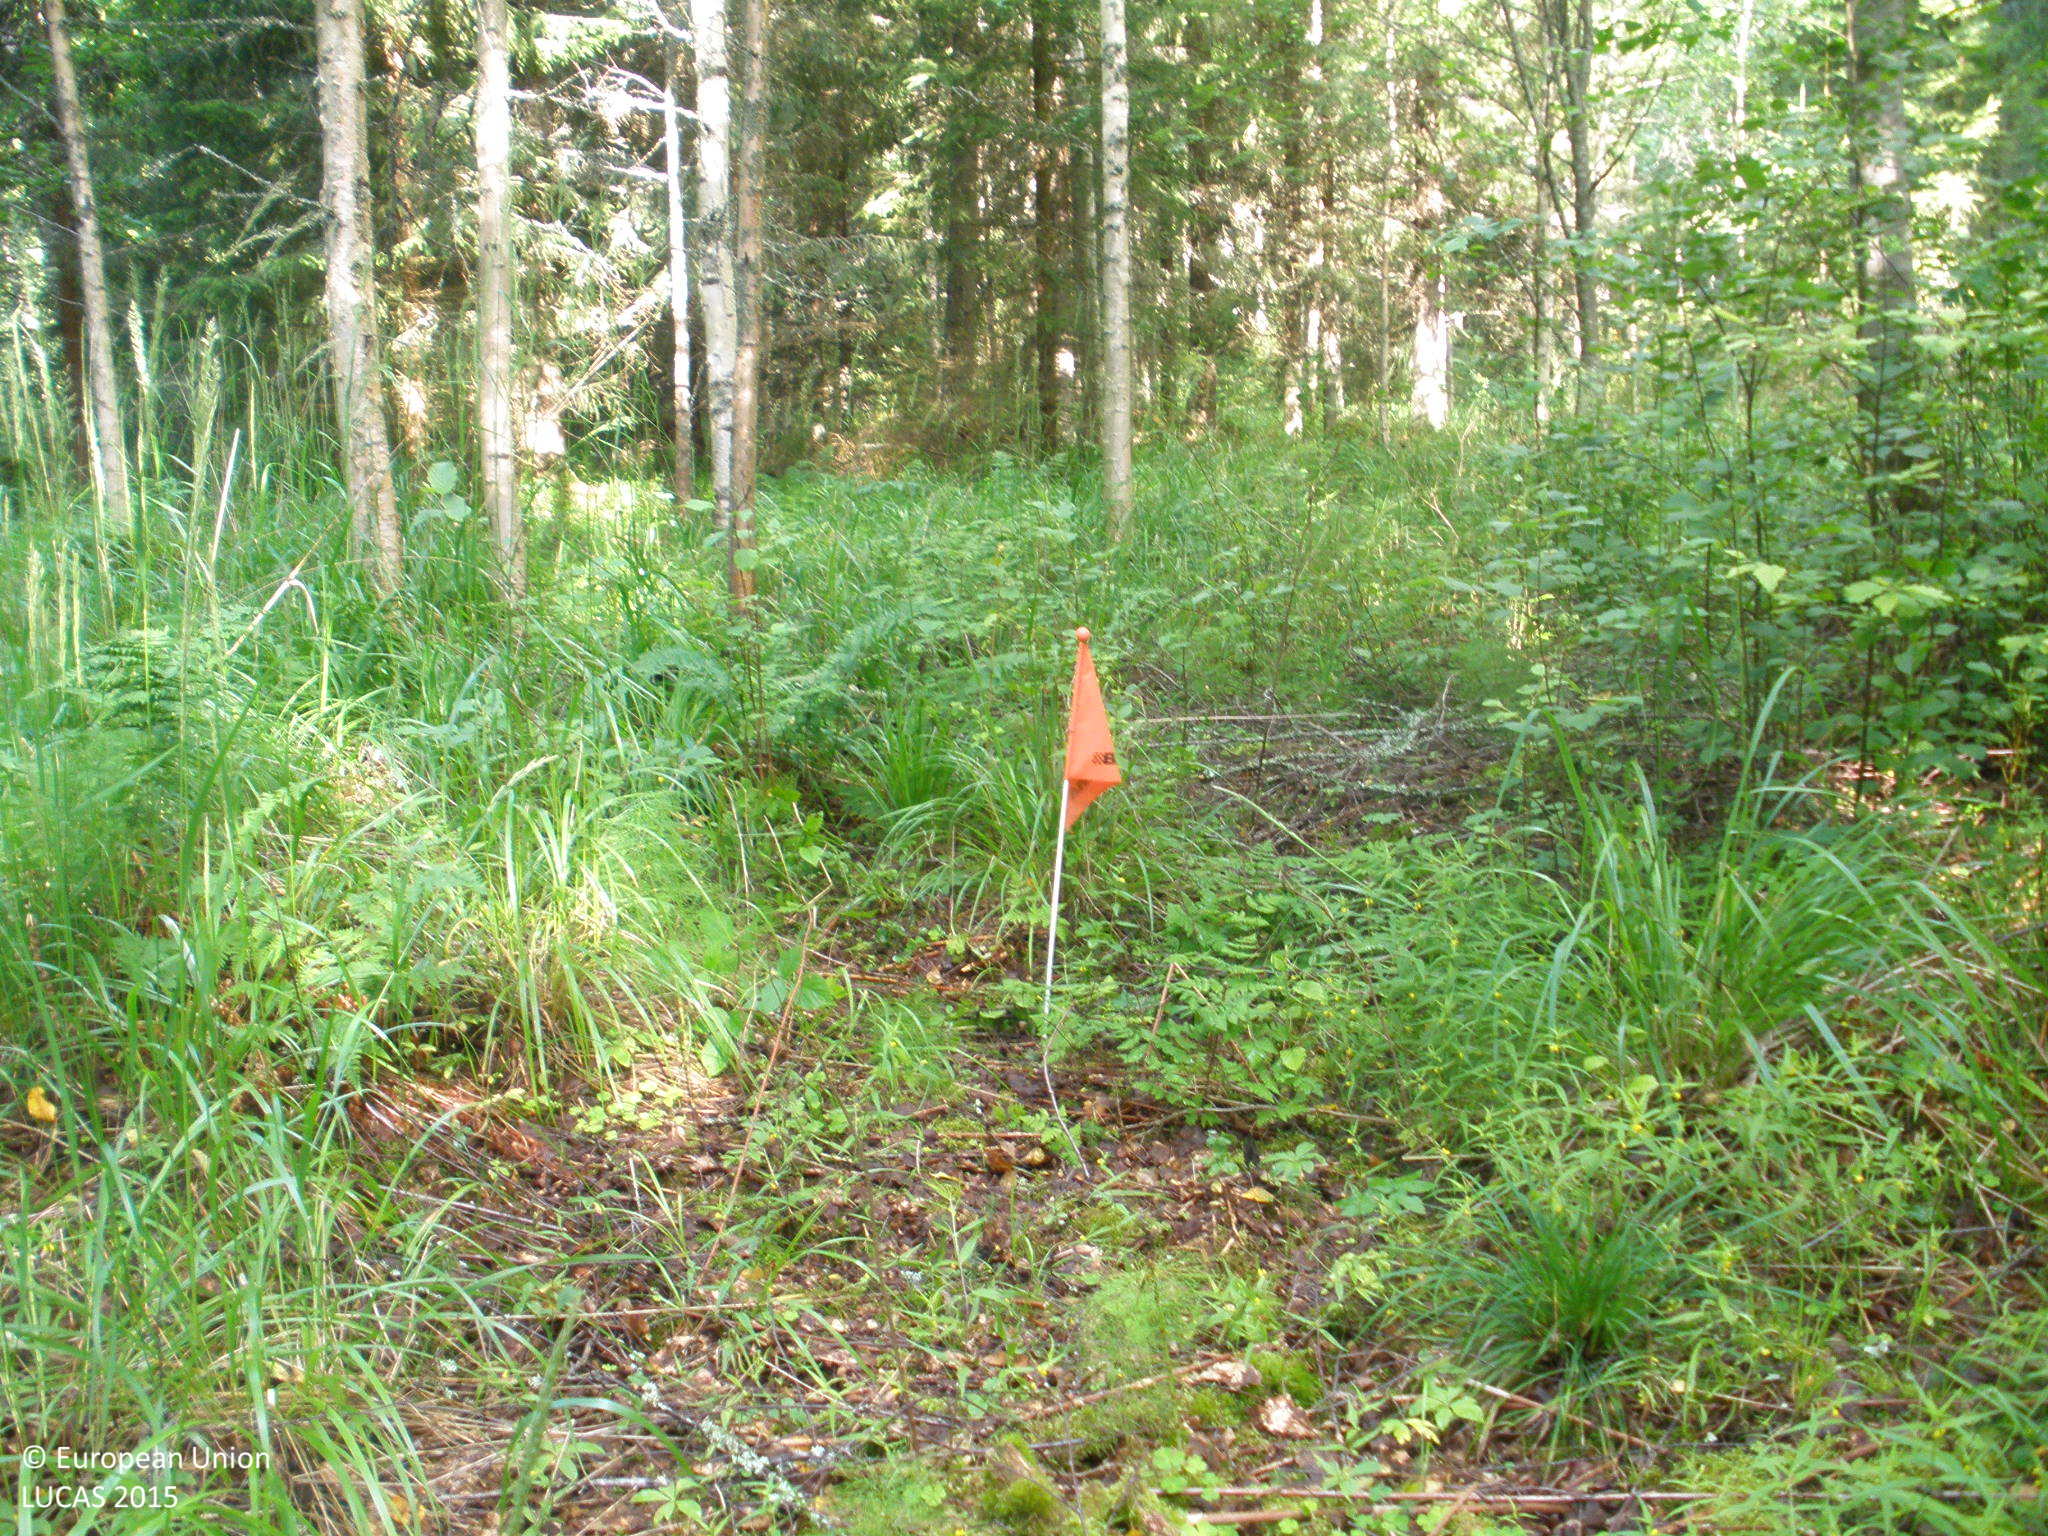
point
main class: Woodland
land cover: Spruce dominated mixed woodland
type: boreal forest
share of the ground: > 75 %
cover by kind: coniferous forest trees 55 %, broadleaved forest trees 30 %, herbaceous plants 10 %, shrubs 5 %
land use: Forestry
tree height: > 5 m
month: July
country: FI
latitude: 60.9826
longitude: 25.0661
